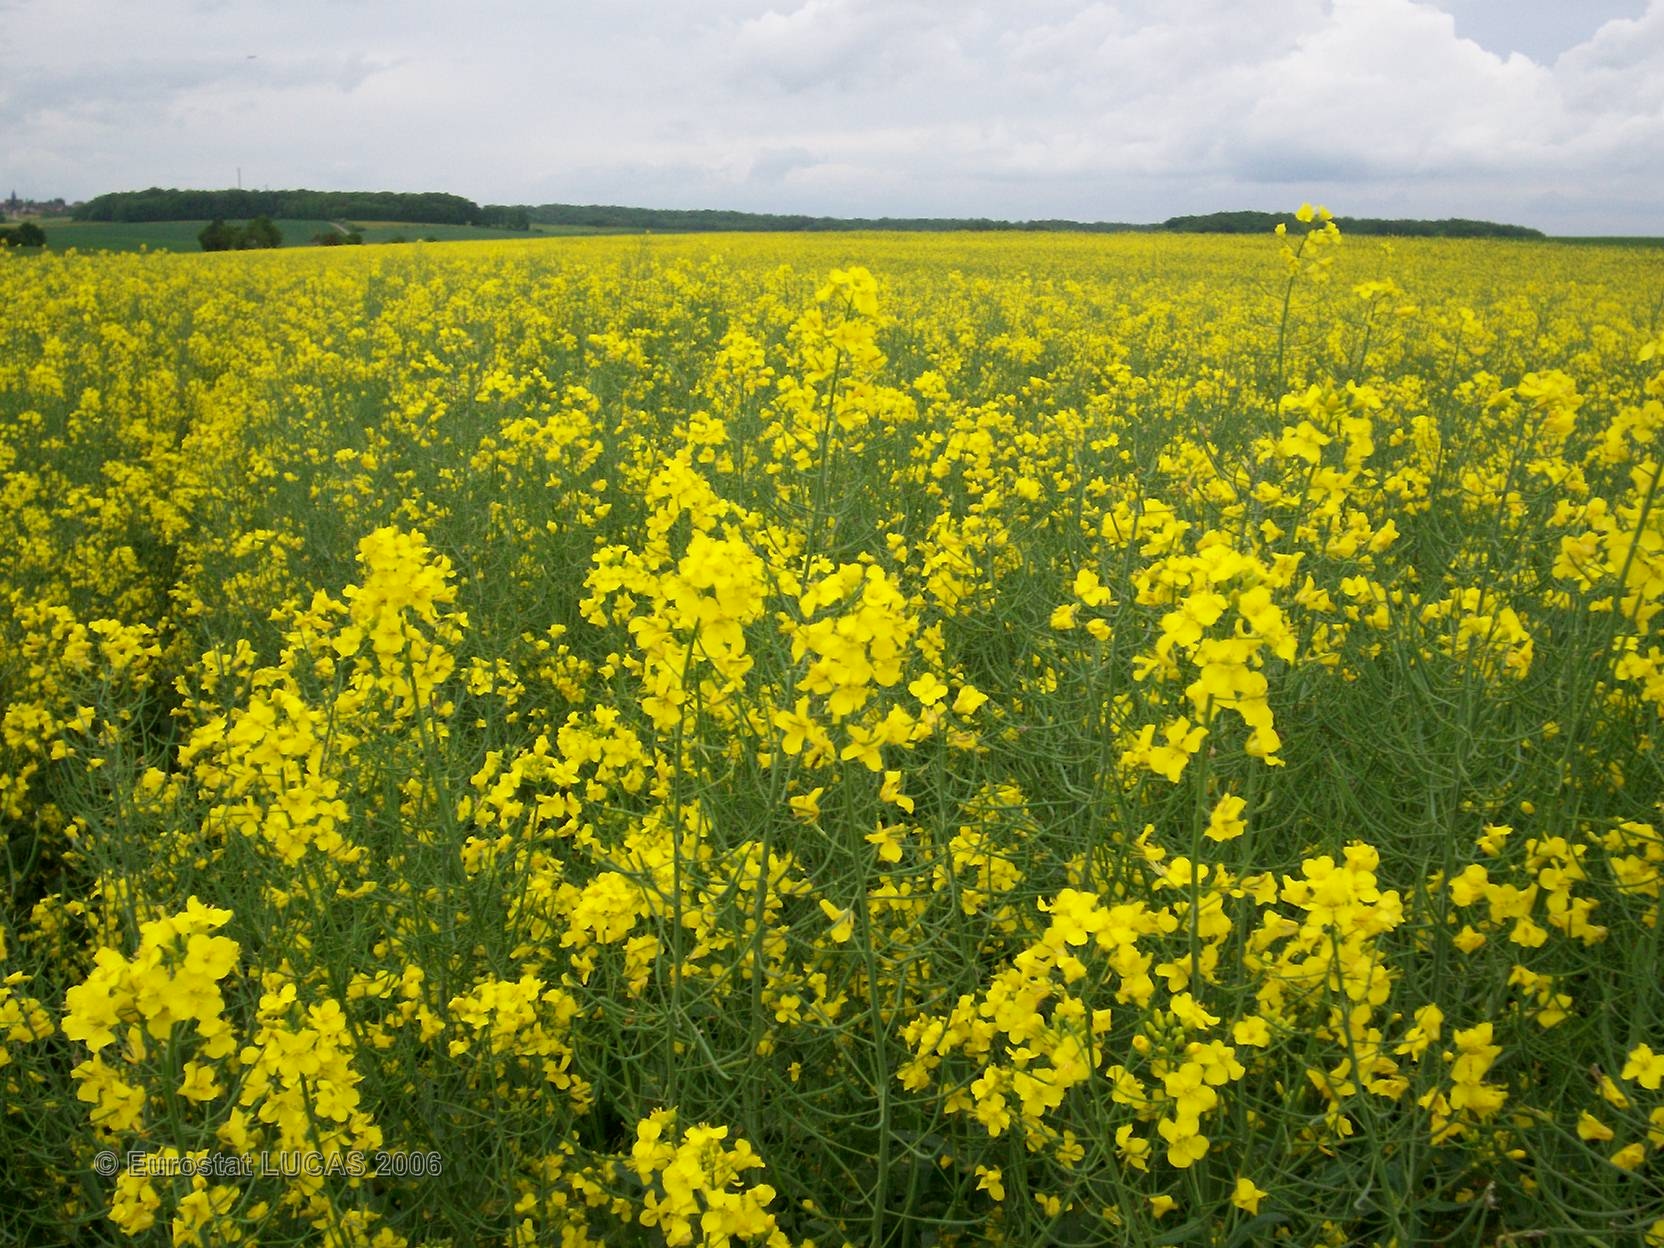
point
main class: Cropland
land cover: Rape and turnip rape
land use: Agriculture (excluding fallow land and kitchen gardens)
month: May
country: FR
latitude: 48.1943
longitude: 4.4954
